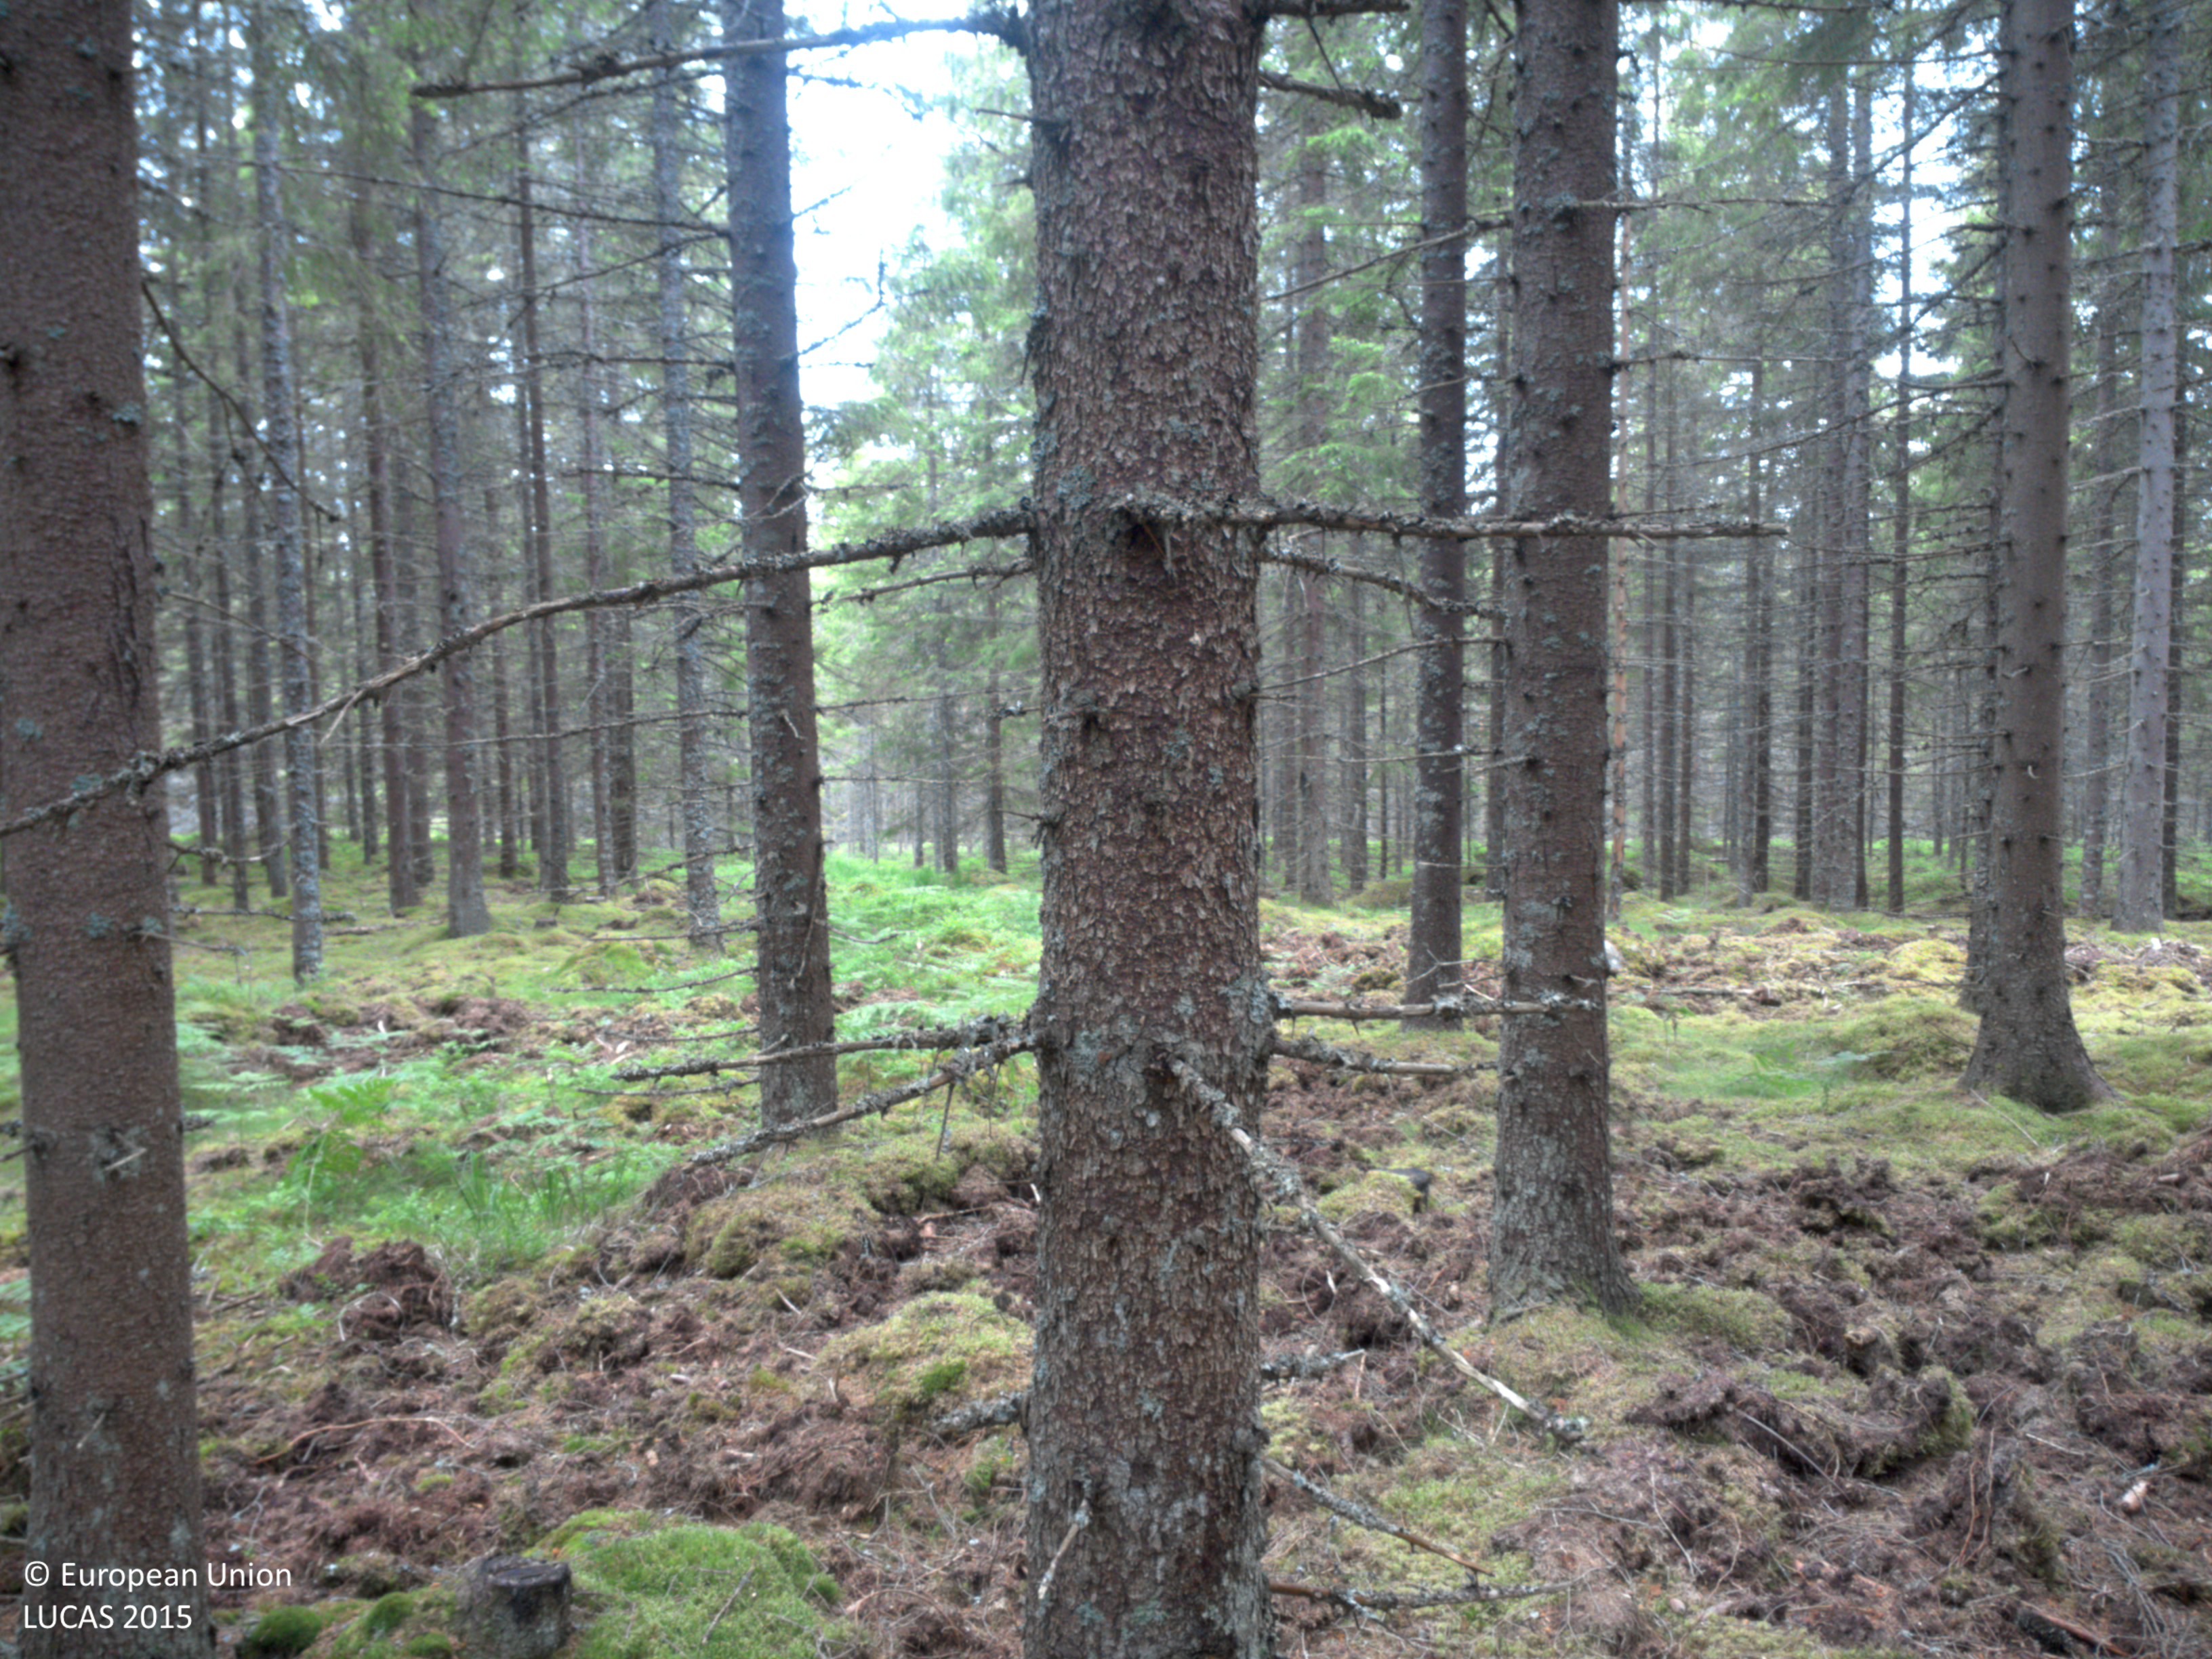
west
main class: Woodland
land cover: Spruce dominated coniferous woodland
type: boreal forest
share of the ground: 50 - 75 %
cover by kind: coniferous forest trees 65 %, lichens and mosses 35 %
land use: Forestry
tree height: > 5 m
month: June
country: SE
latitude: 58.9969
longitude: 11.9622
